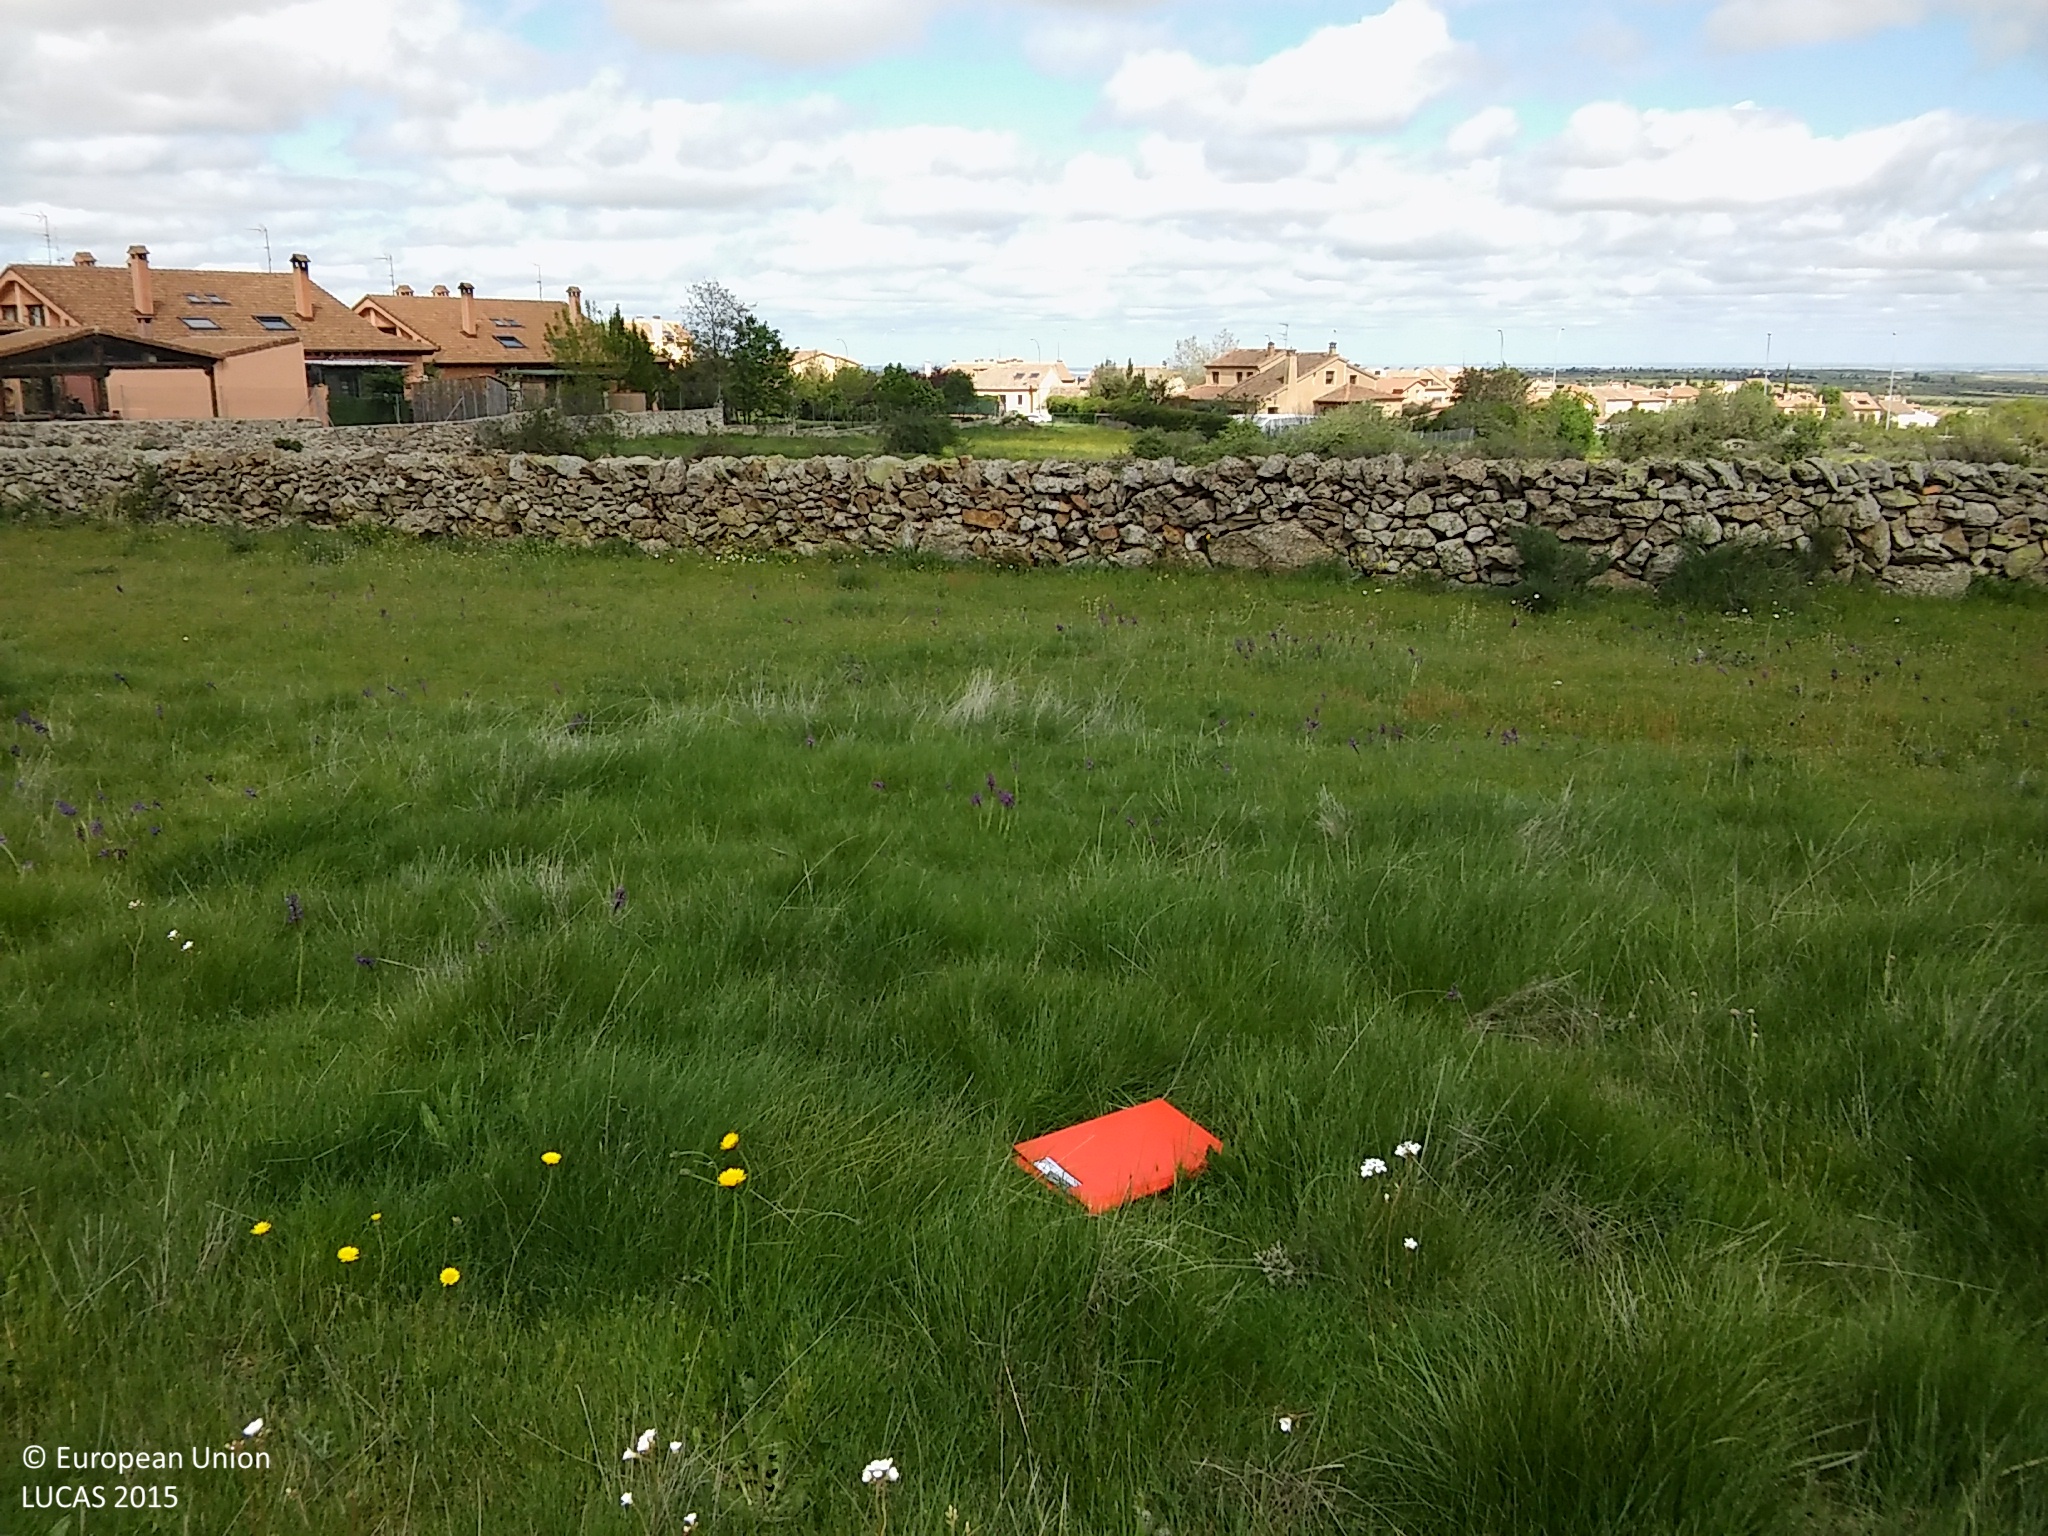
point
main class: Grassland
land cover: Grassland without tree/shrub cover
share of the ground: > 75 %
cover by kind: herbaceous plants 95 %, shrubs 5 %
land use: Agriculture (excluding fallow land and kitchen gardens)
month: May
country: ES
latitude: 40.9963
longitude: -4.0176
